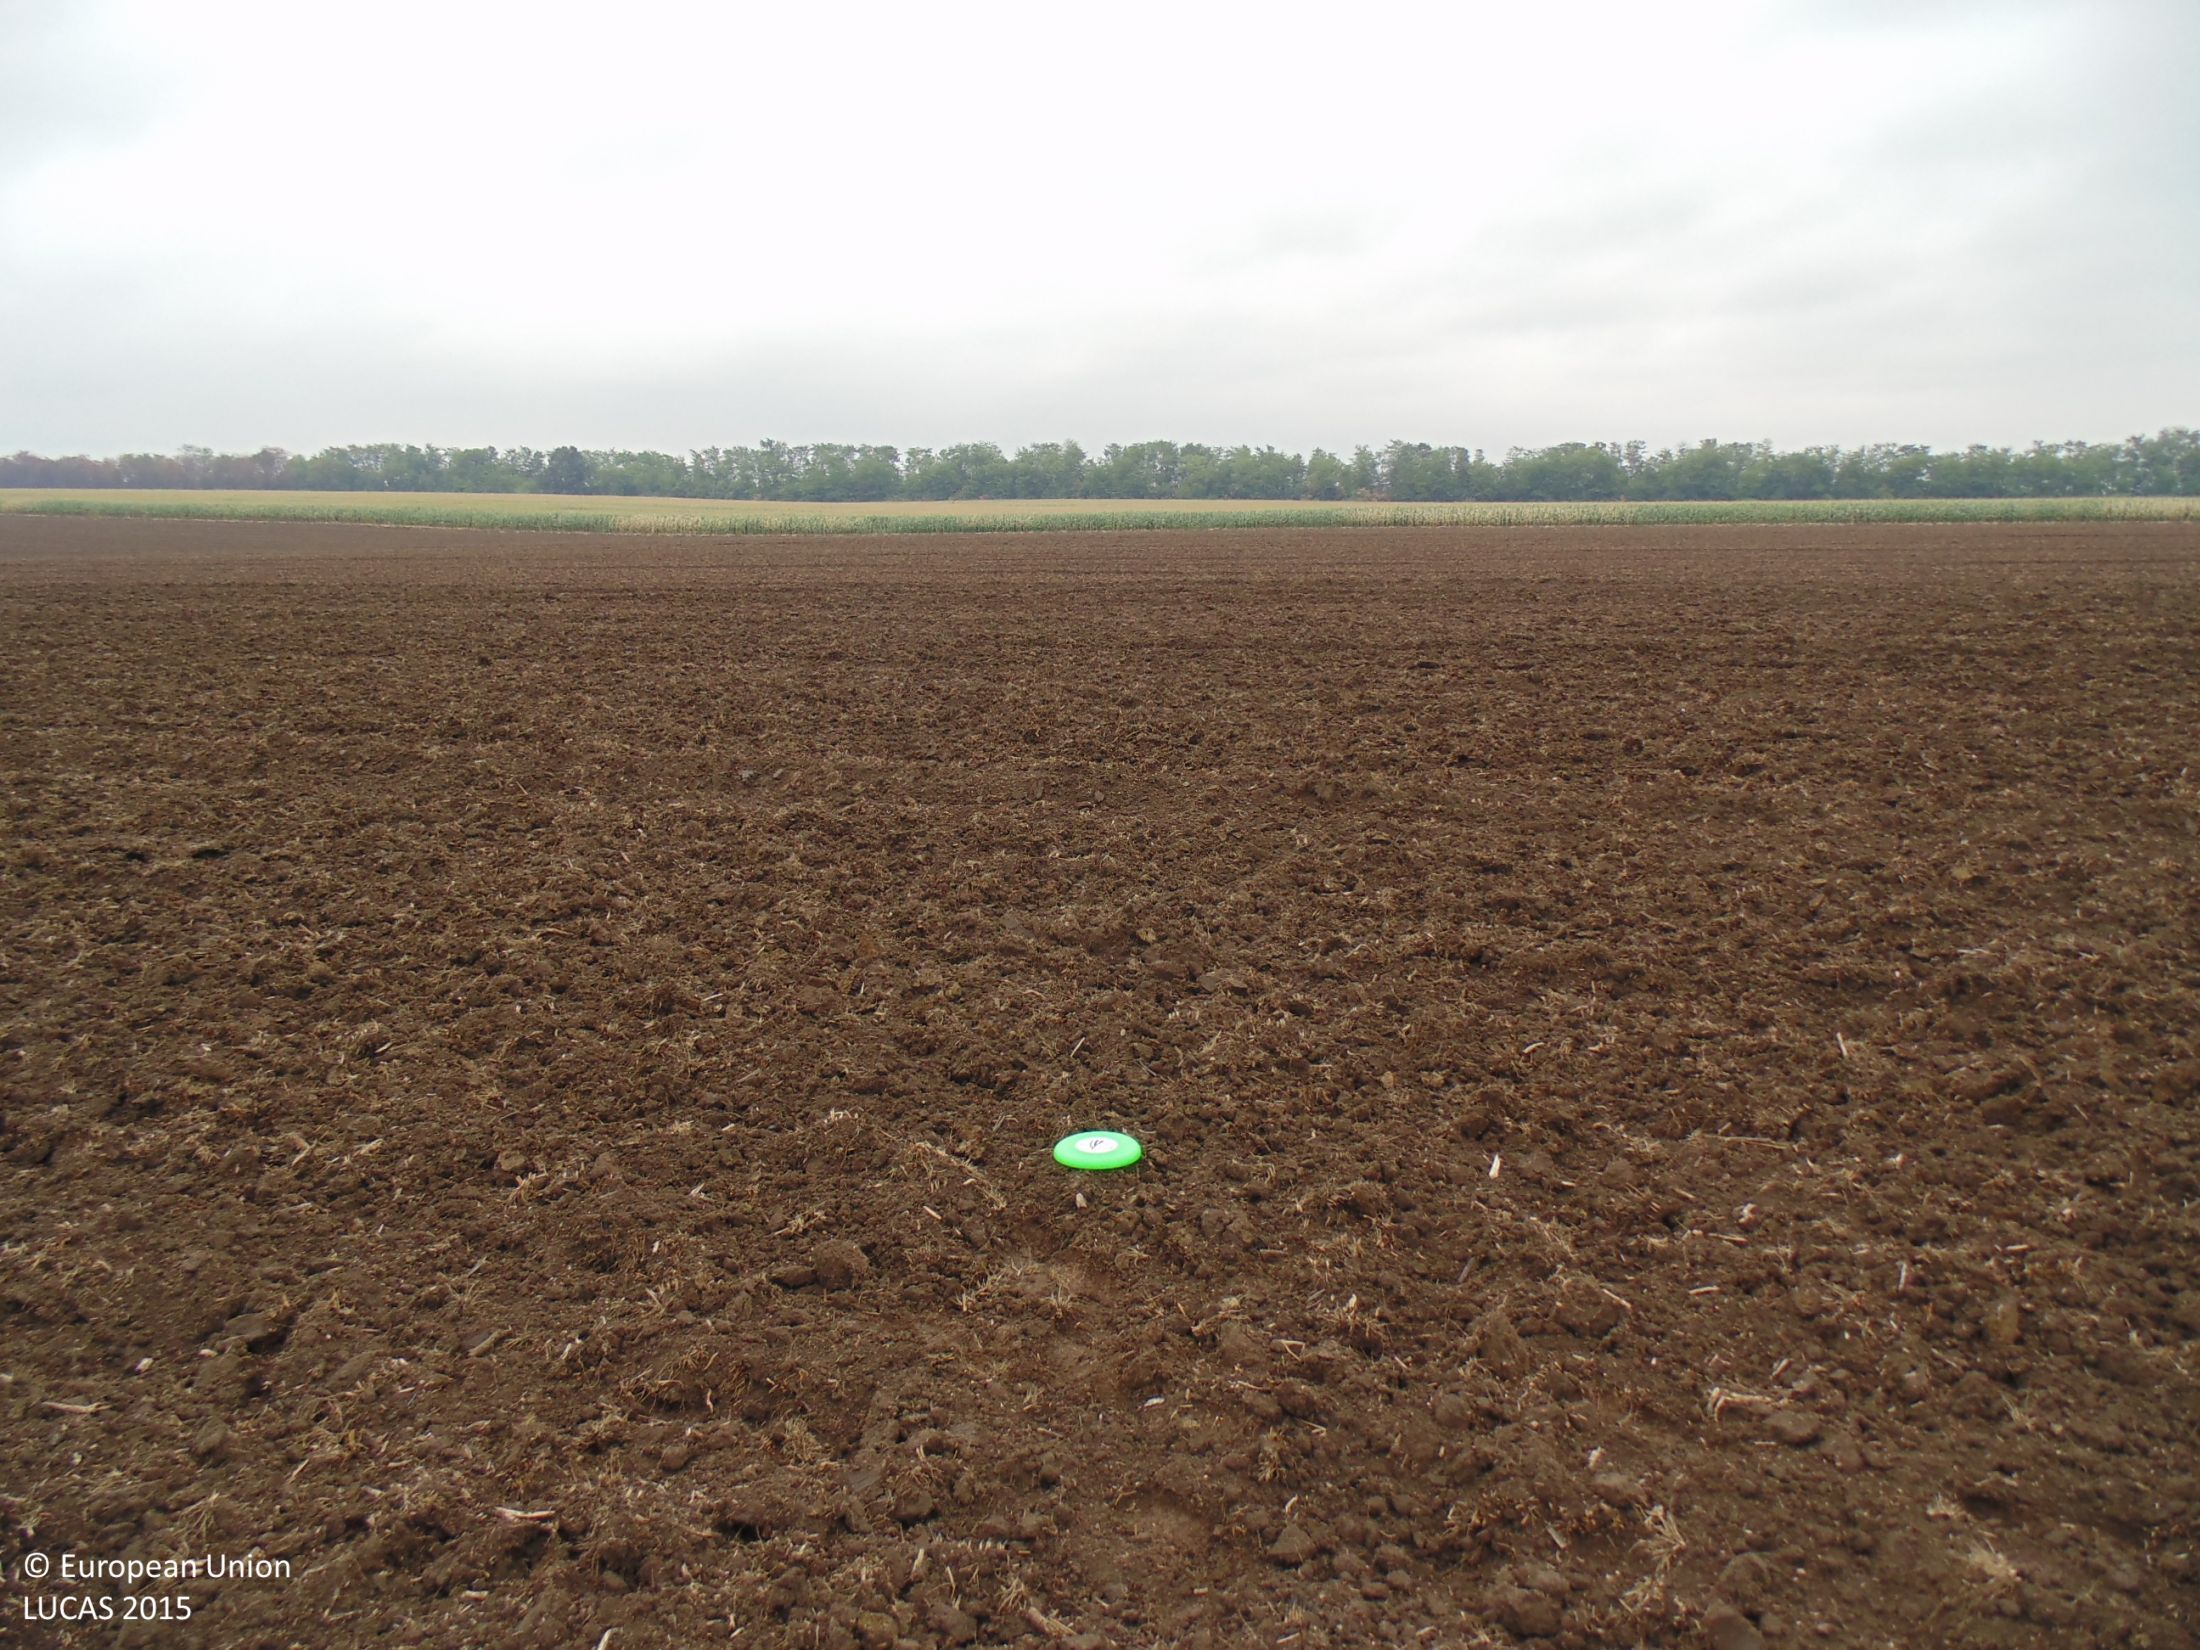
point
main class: Cropland
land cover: Common wheat
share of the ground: < 10 %
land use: Agriculture (excluding fallow land and kitchen gardens)
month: August
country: BG
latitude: 43.9008
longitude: 27.9144
